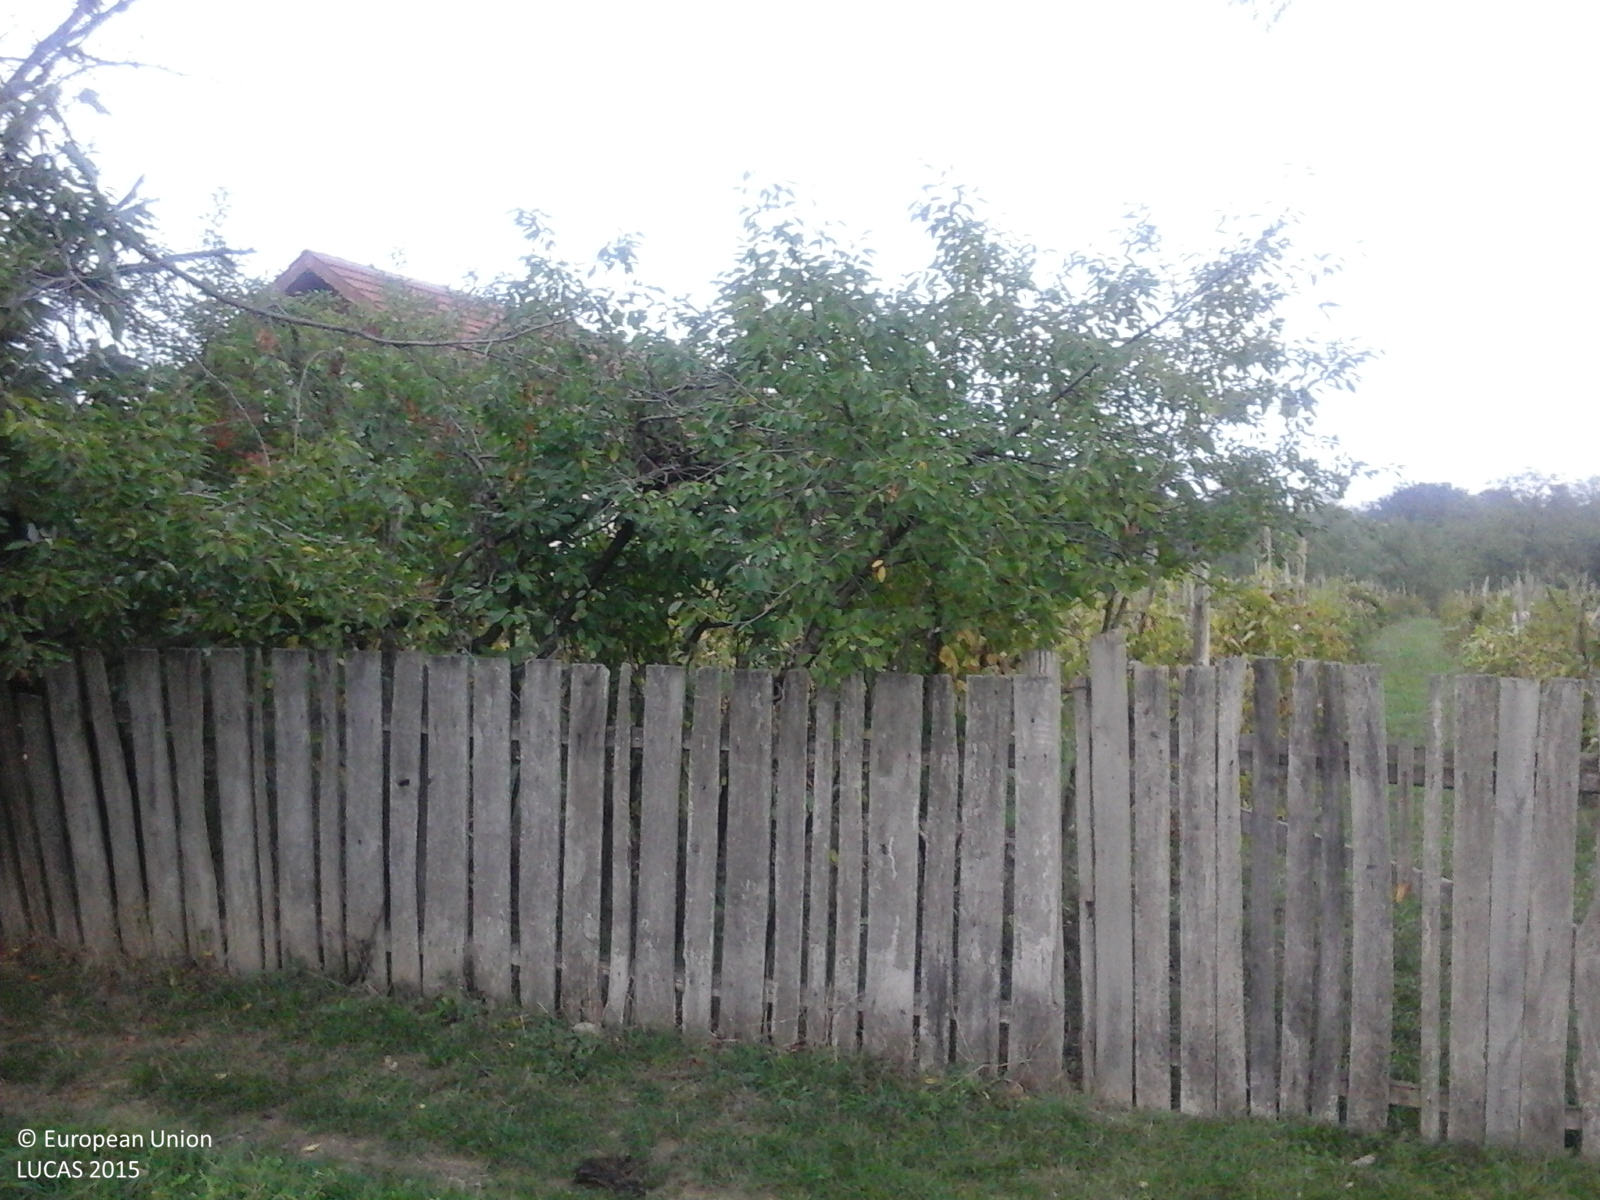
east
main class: Cropland
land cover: Vineyards
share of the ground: > 75 %
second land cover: Grassland without tree/shrub cover
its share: > 75 %
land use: Agriculture (excluding fallow land and kitchen gardens)
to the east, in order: Vineyards; Grassland without tree/shrub cover; Fences; Arable land (only in case pi); Broadleaved woodland
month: September
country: RO
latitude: 44.9346
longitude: 23.4239
